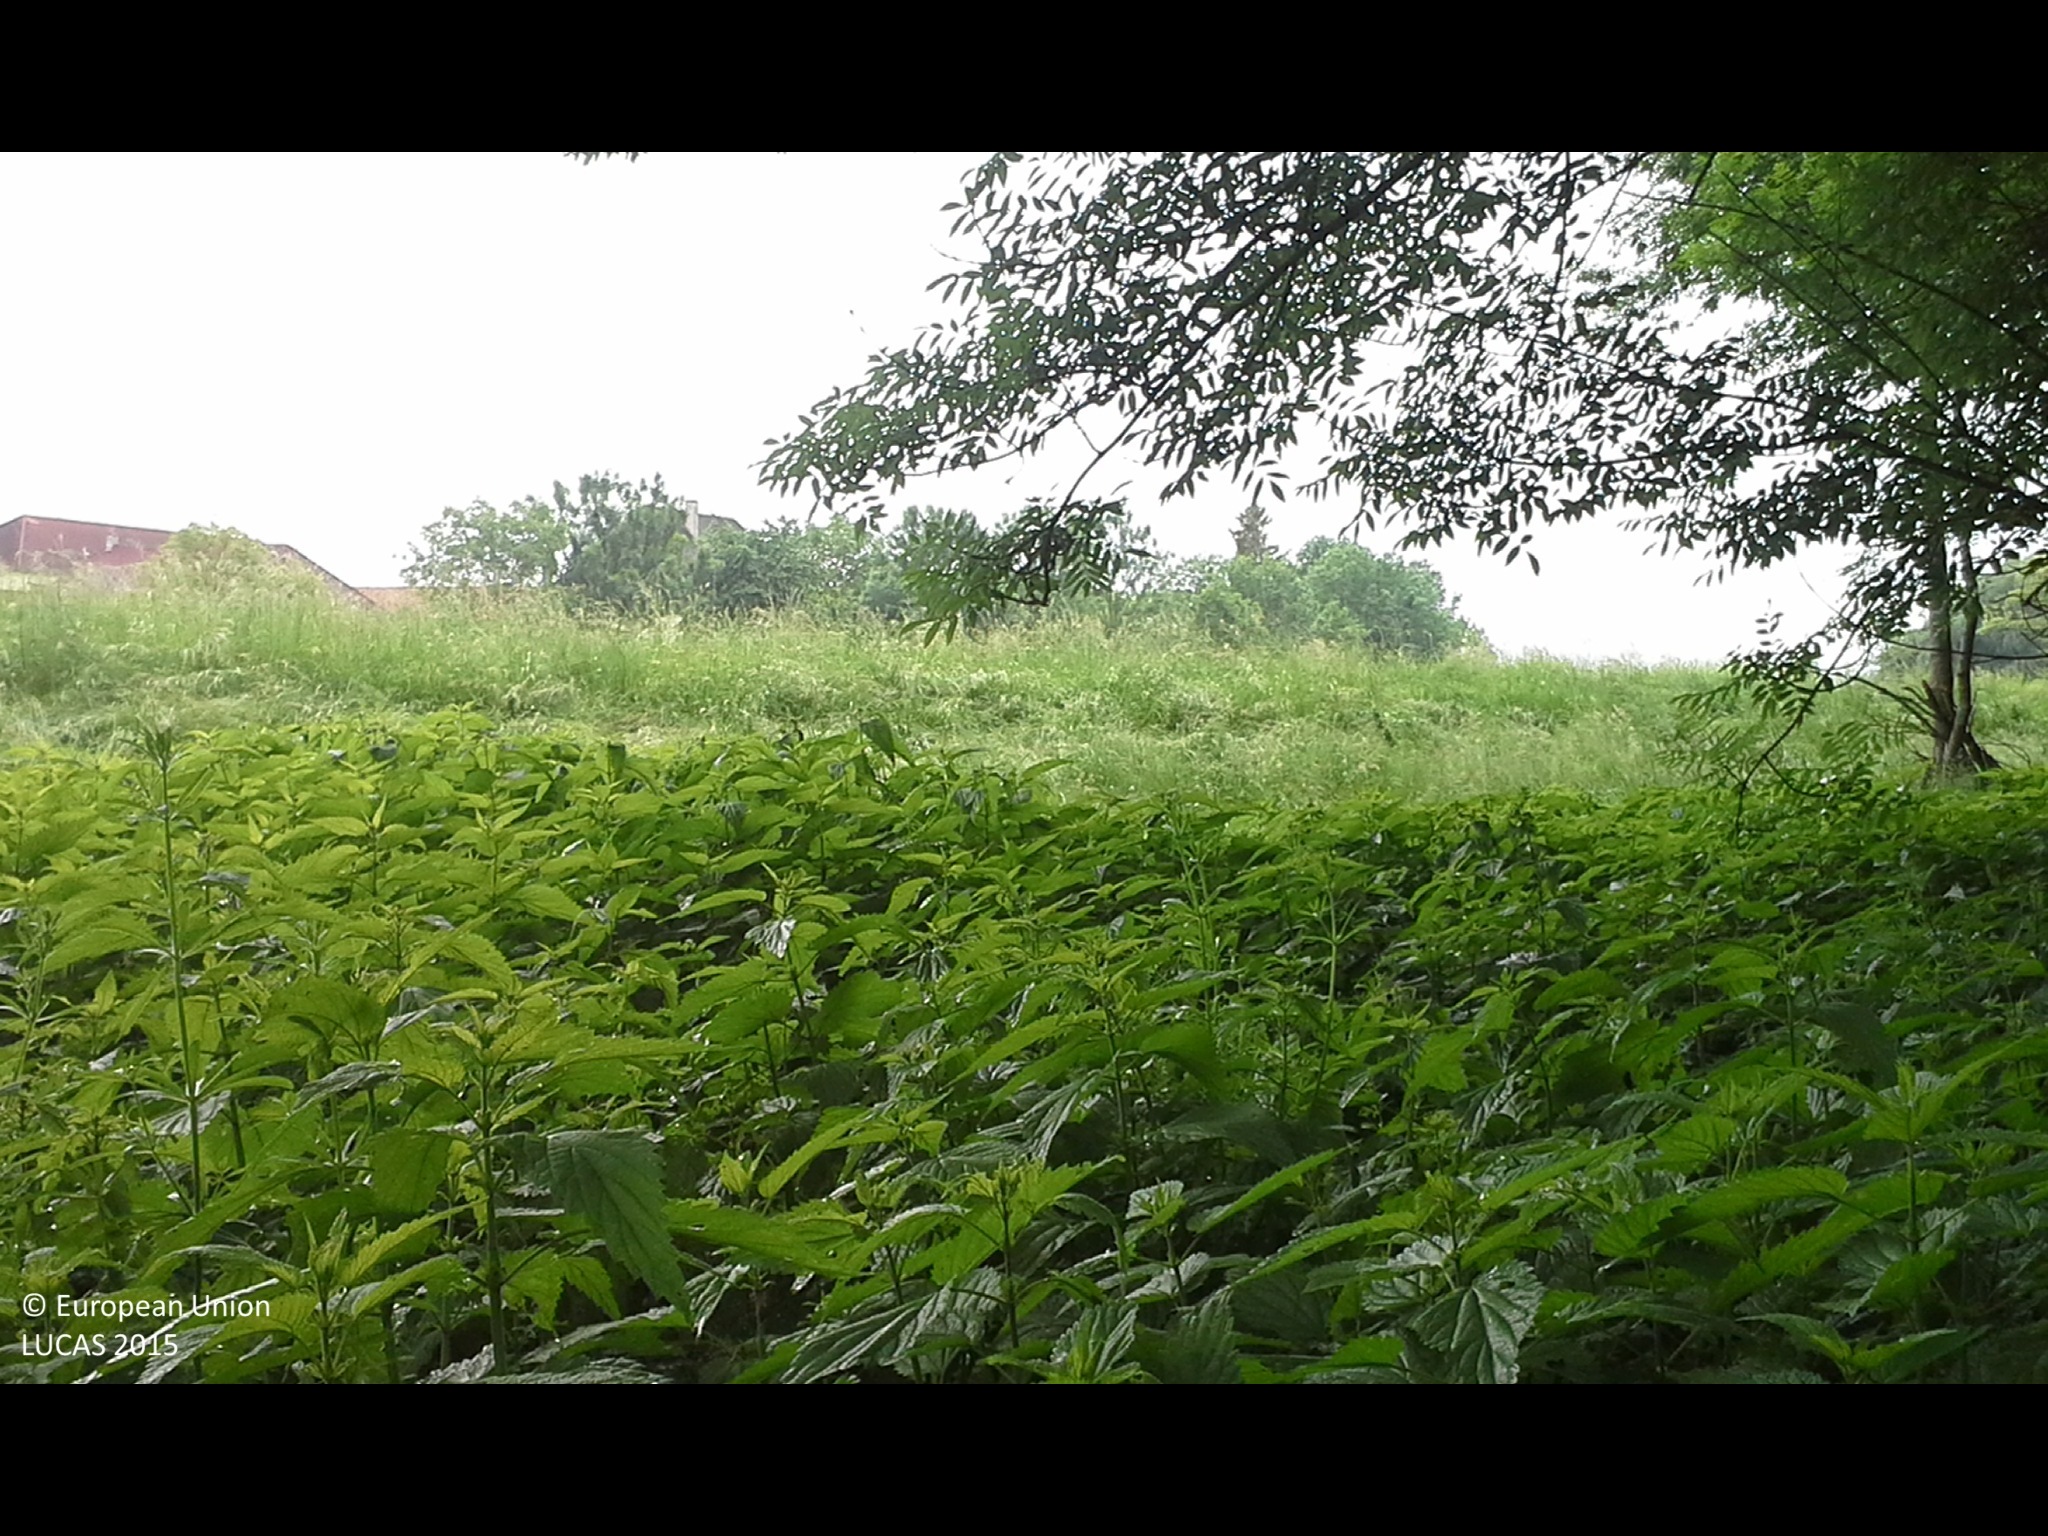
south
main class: Woodland
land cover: Broadleaved woodland
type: floodplain forest
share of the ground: > 75 %
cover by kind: broadleaved forest trees 100 %
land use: Forestry
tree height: > 5 m
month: May
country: AT
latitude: 48.2300
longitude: 14.2946
